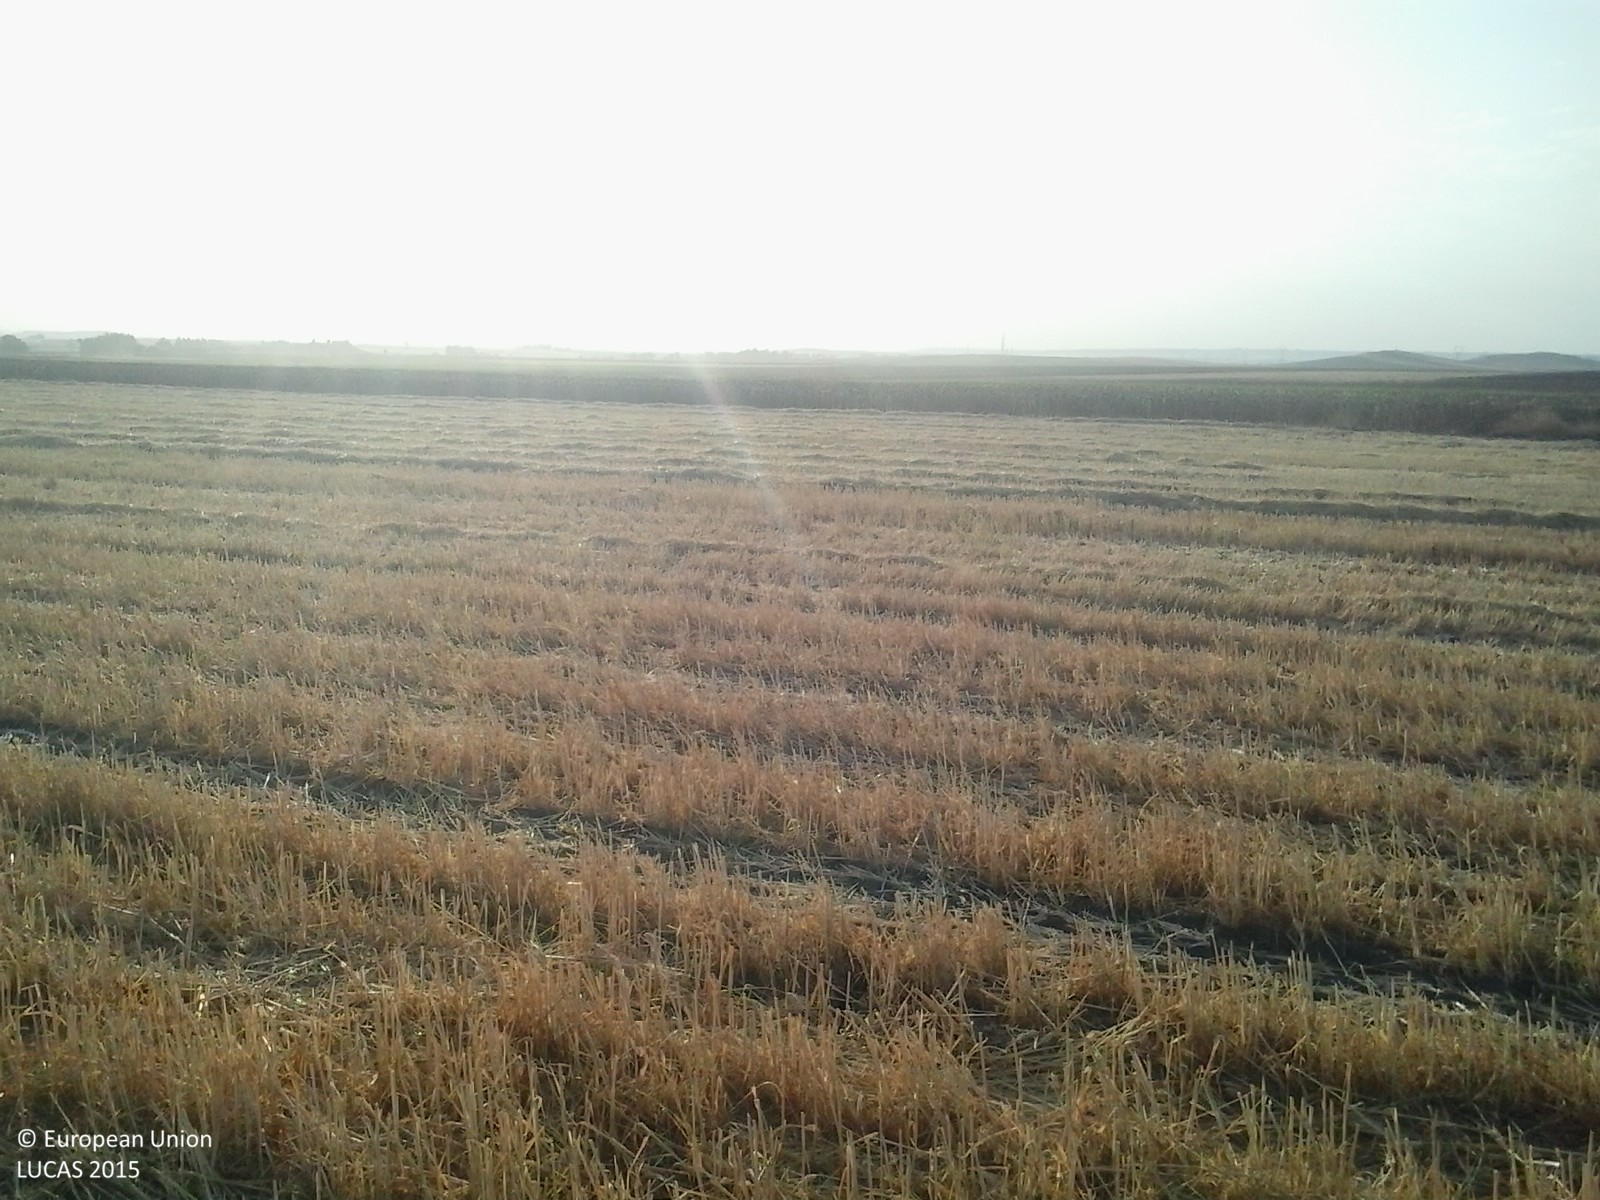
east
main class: Cropland
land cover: Common wheat
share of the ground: < 10 %
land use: Agriculture (excluding fallow land and kitchen gardens)
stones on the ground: < 10 %
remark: Harvested field
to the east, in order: Common wheat; Sunflower; Tracks; Grass margins; Sunflower
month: July
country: ES
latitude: 37.4412
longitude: -6.3864
